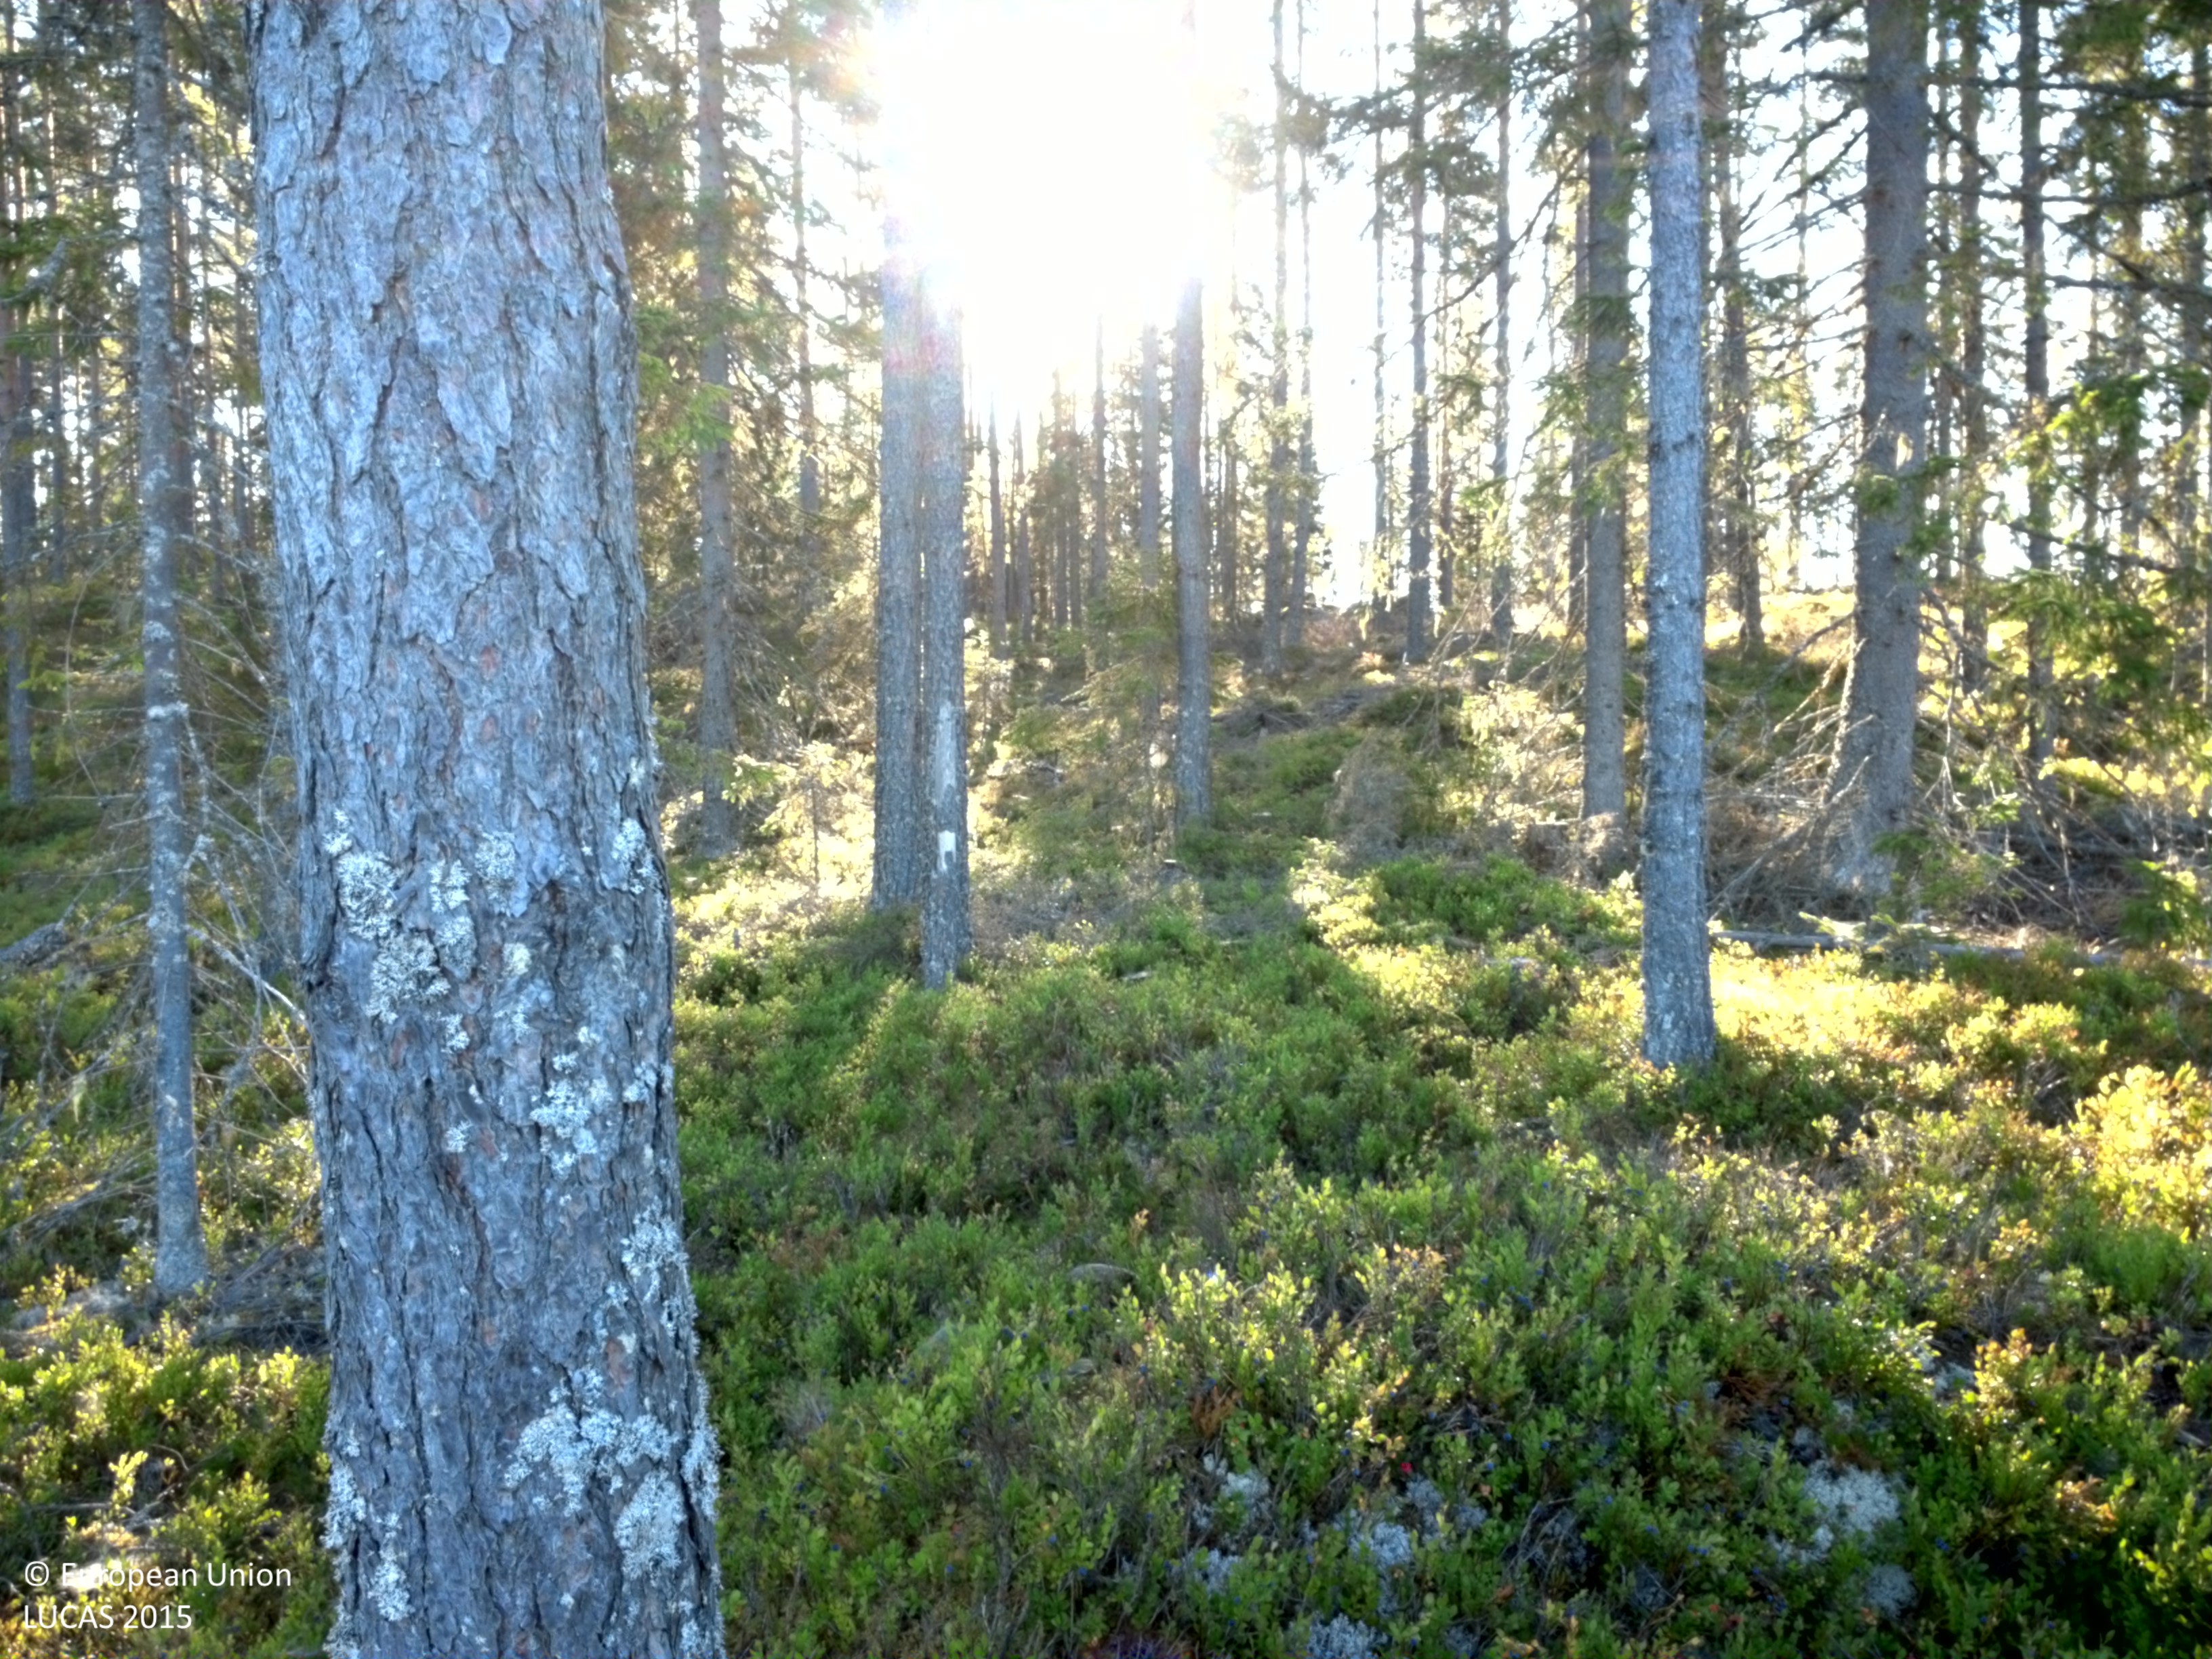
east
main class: Woodland
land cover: Other coniferous woodland
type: boreal forest
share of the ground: 50 - 75 %
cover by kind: coniferous forest trees 70 %, shrubs 30 %
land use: Forestry
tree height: > 5 m
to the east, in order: Other coniferous woodland; Spruce dominated coniferous woodland; Shrubland with sparse tree cover
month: August
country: SE
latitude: 60.0109
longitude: 14.1690
